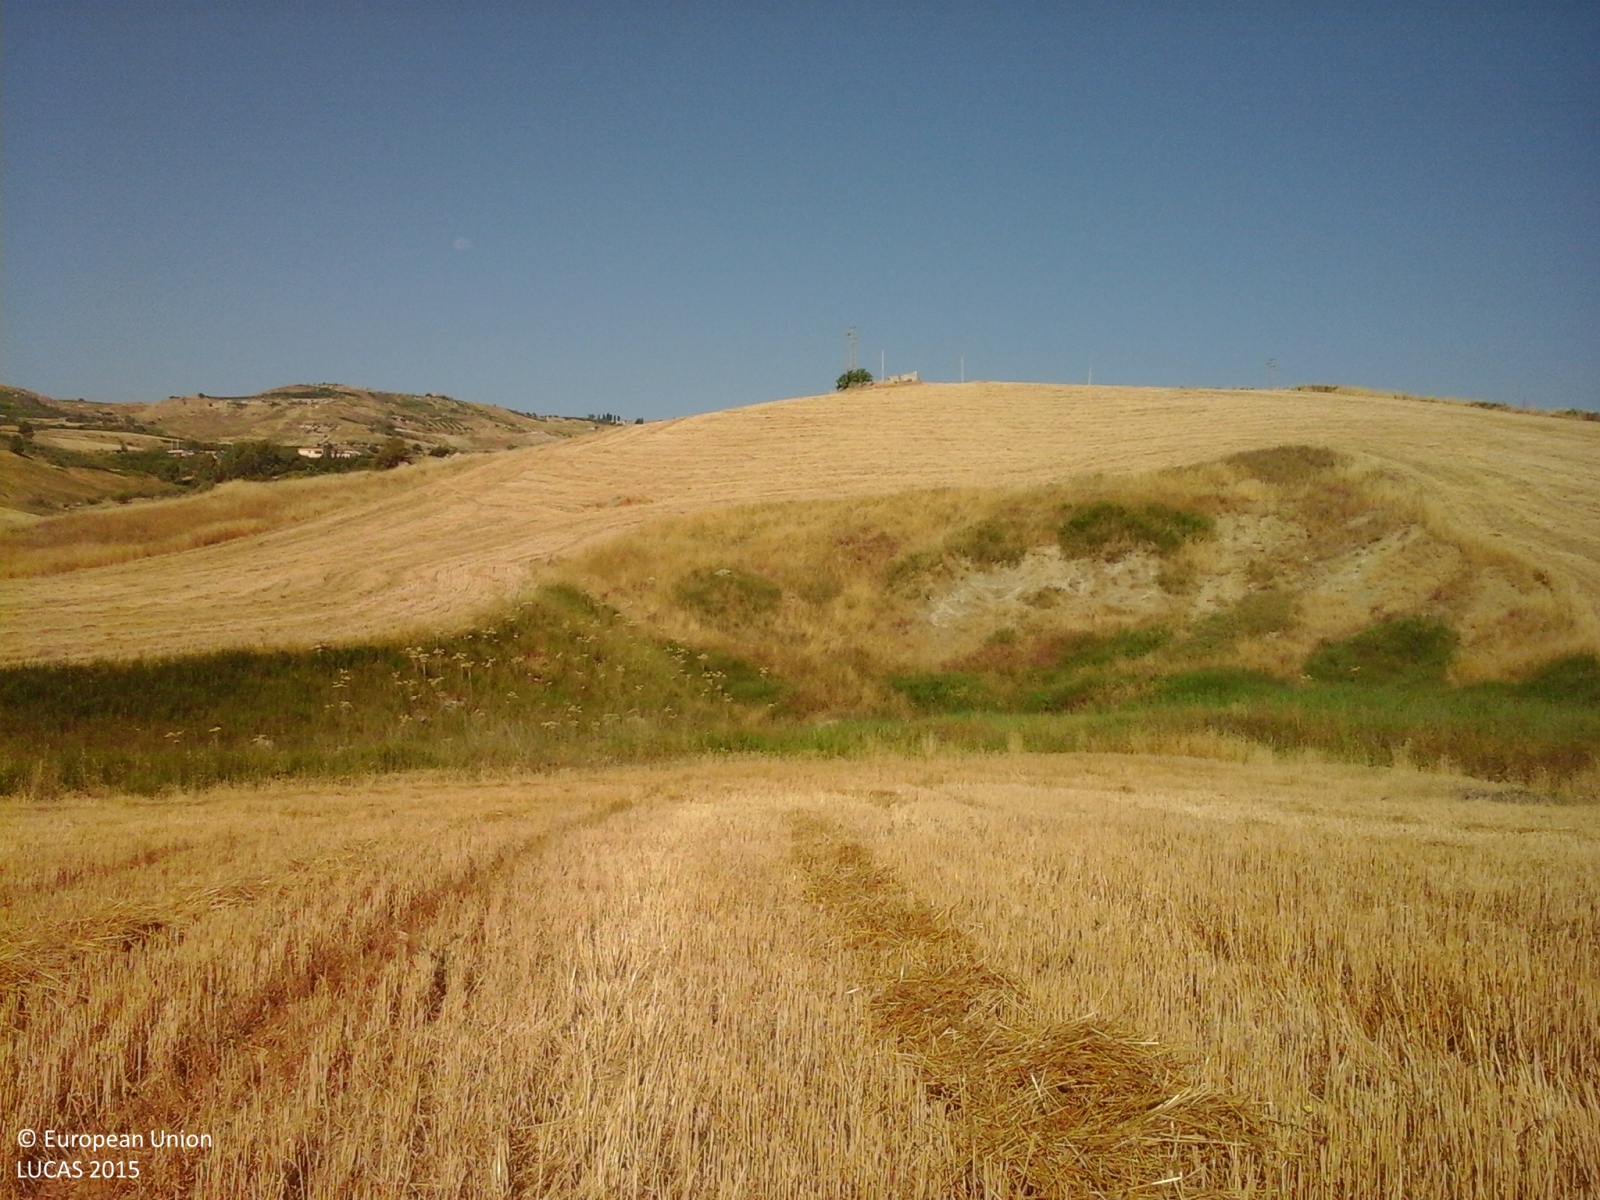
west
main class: Cropland
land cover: Durum wheat
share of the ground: > 75 %
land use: Agriculture (excluding fallow land and kitchen gardens)
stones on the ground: < 10 %
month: July
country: IT
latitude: 37.3541
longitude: 13.5512
